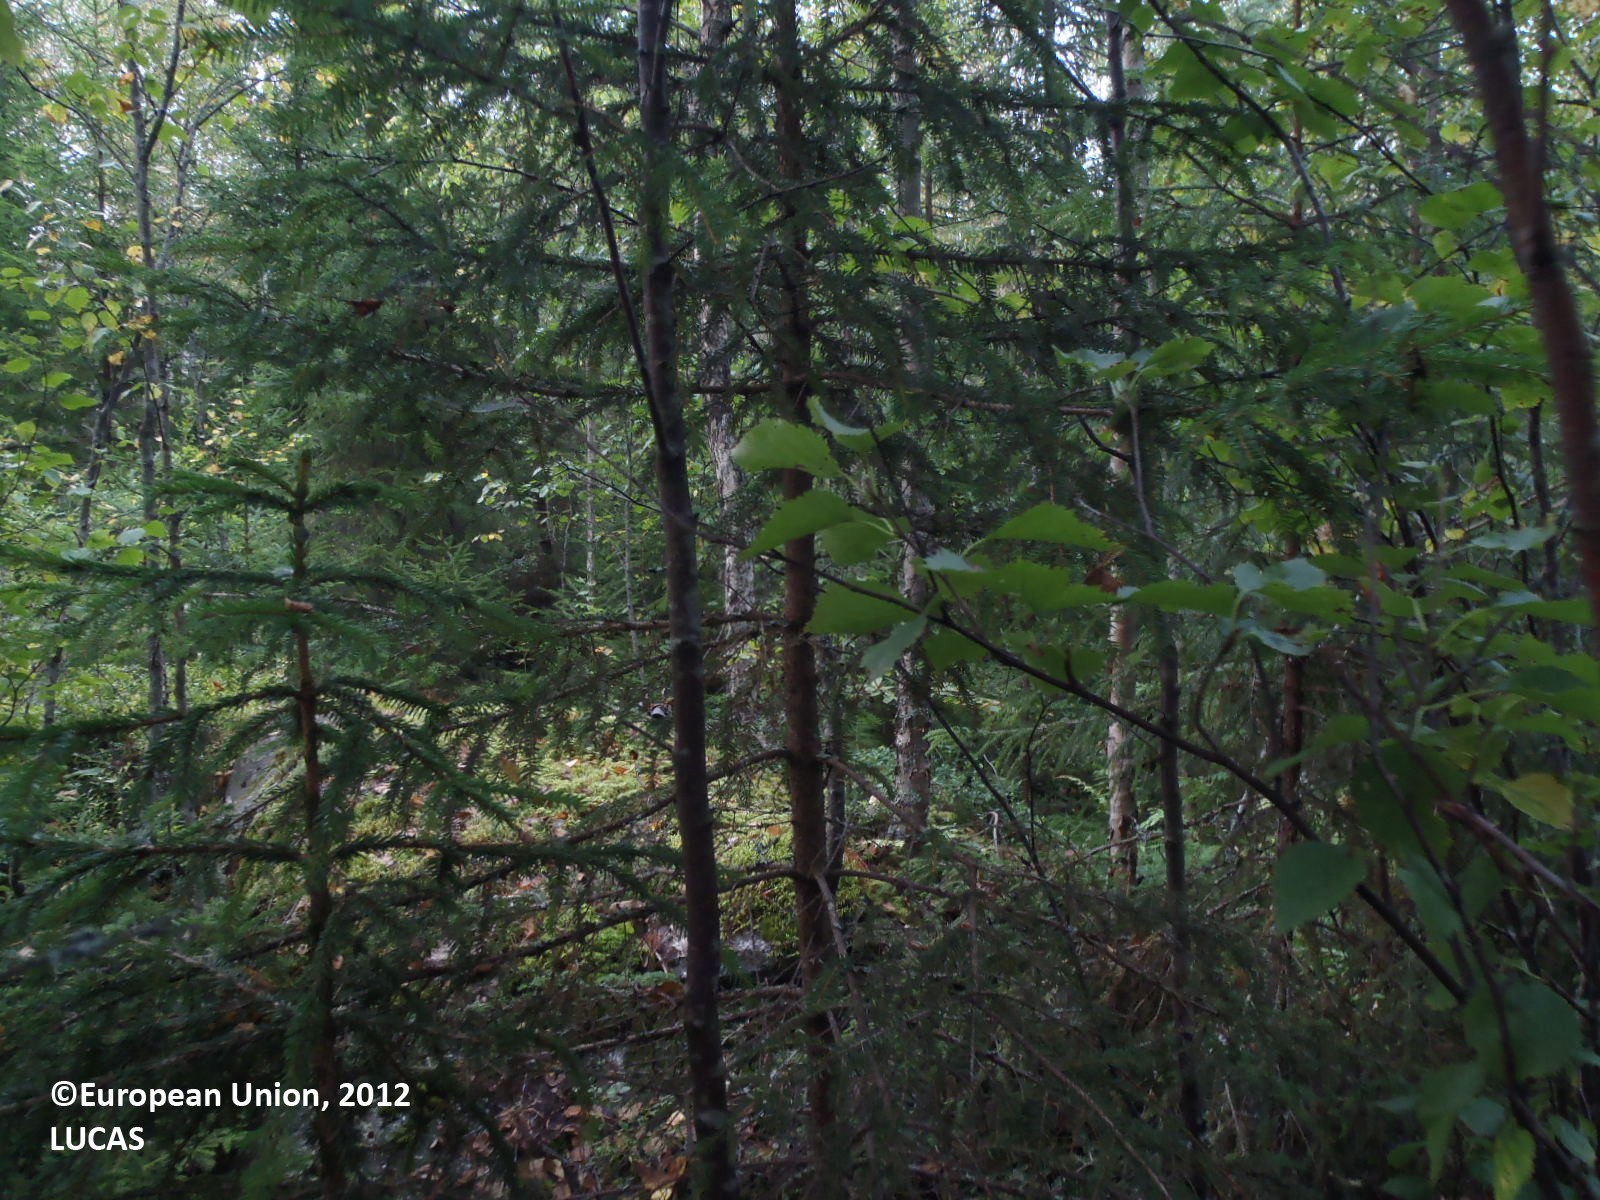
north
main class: Woodland
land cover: Pine dominated mixed woodland
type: boreal forest
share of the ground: > 75 %
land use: Forestry
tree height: > 5 m
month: September
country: FI
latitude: 61.3270
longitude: 22.6405
